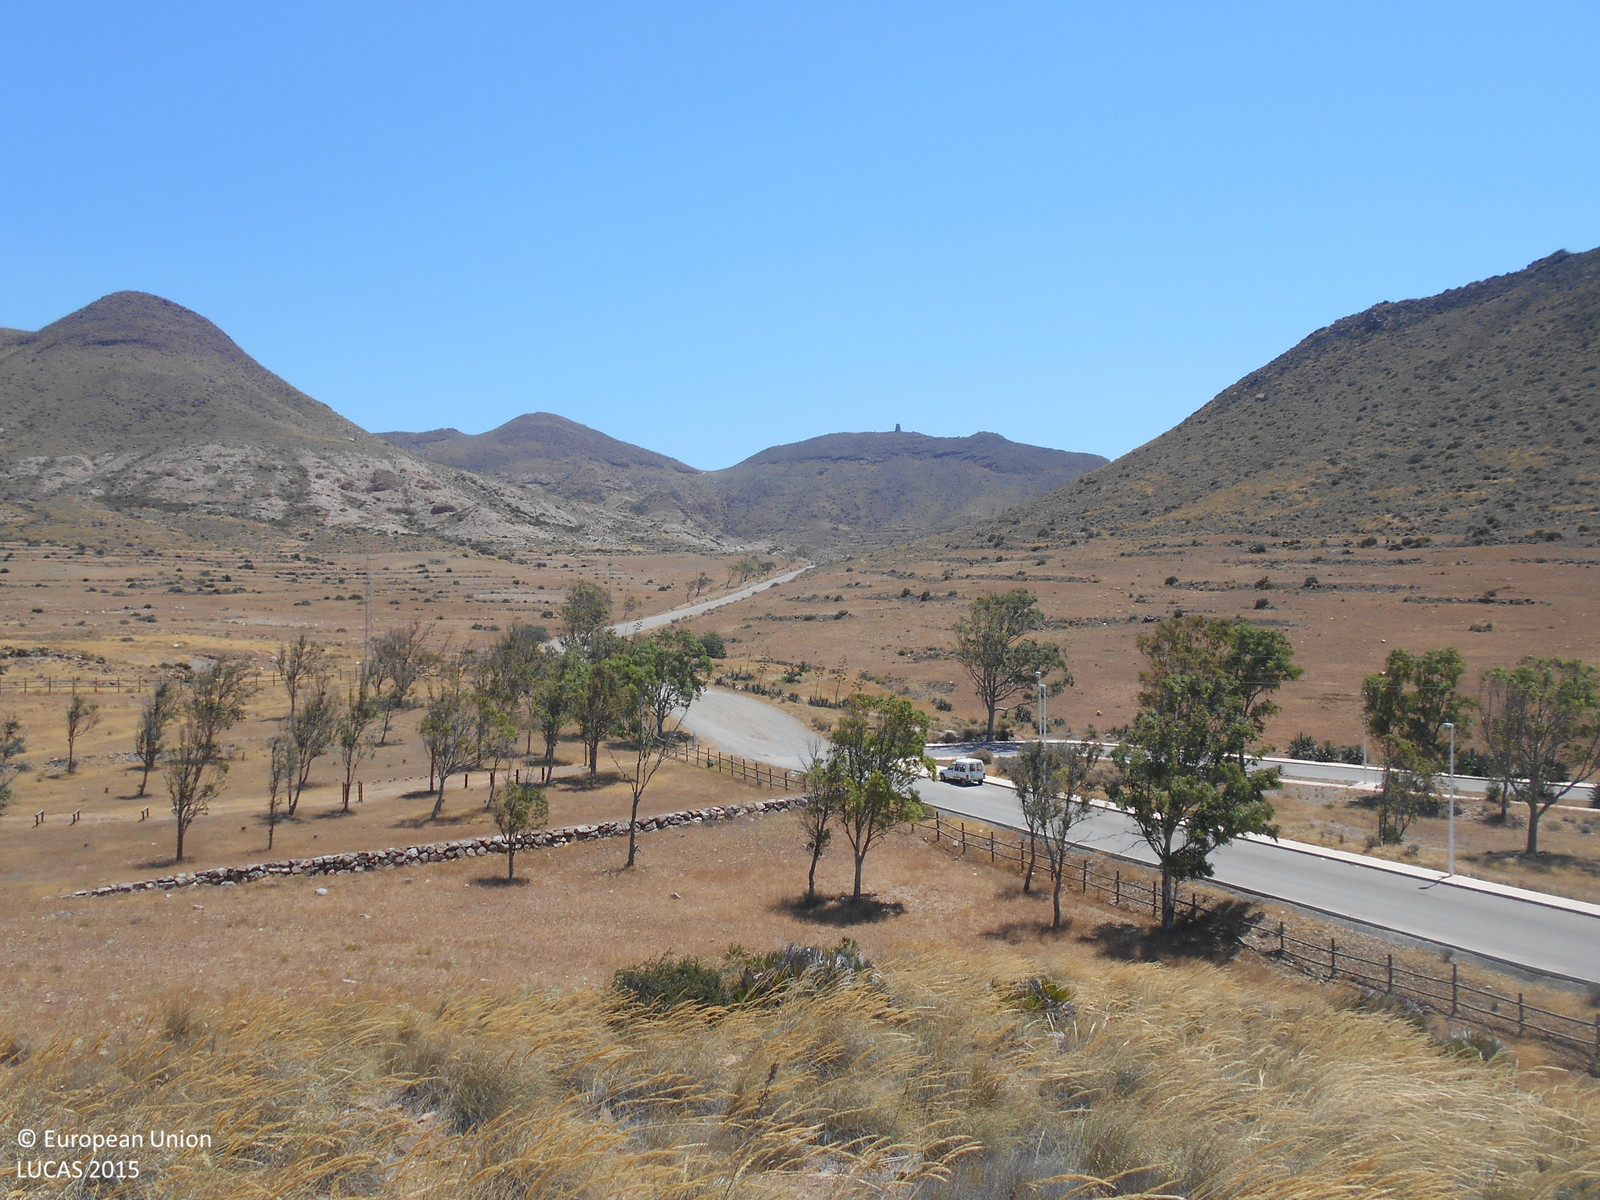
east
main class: Shrubland
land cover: Shrubland without tree cover
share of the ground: 50 - 75 %
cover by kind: shrubs 70 %, herbaceous plants 10 %, consolidated bare surface 10 %, unconsolidated bare surface 10 %
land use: Semi-natural and natural areas not in use
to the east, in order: Shrubland without tree cover; Grassland with sparse tree/shrub cover; Electric lines; Grassland with sparse tree/shrub cover; Dry stone walls; Grassland with sparse tree/shrub cover; Fences; Grassland without tree/shrub cover; Paved roads, cycling and walking lanes; Shrubland without tree cover; Tracks; Grassland with sparse tree/shrub cover; Grassland without tree/shrub cover
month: May
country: ES
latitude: 36.7696
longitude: -2.1053
